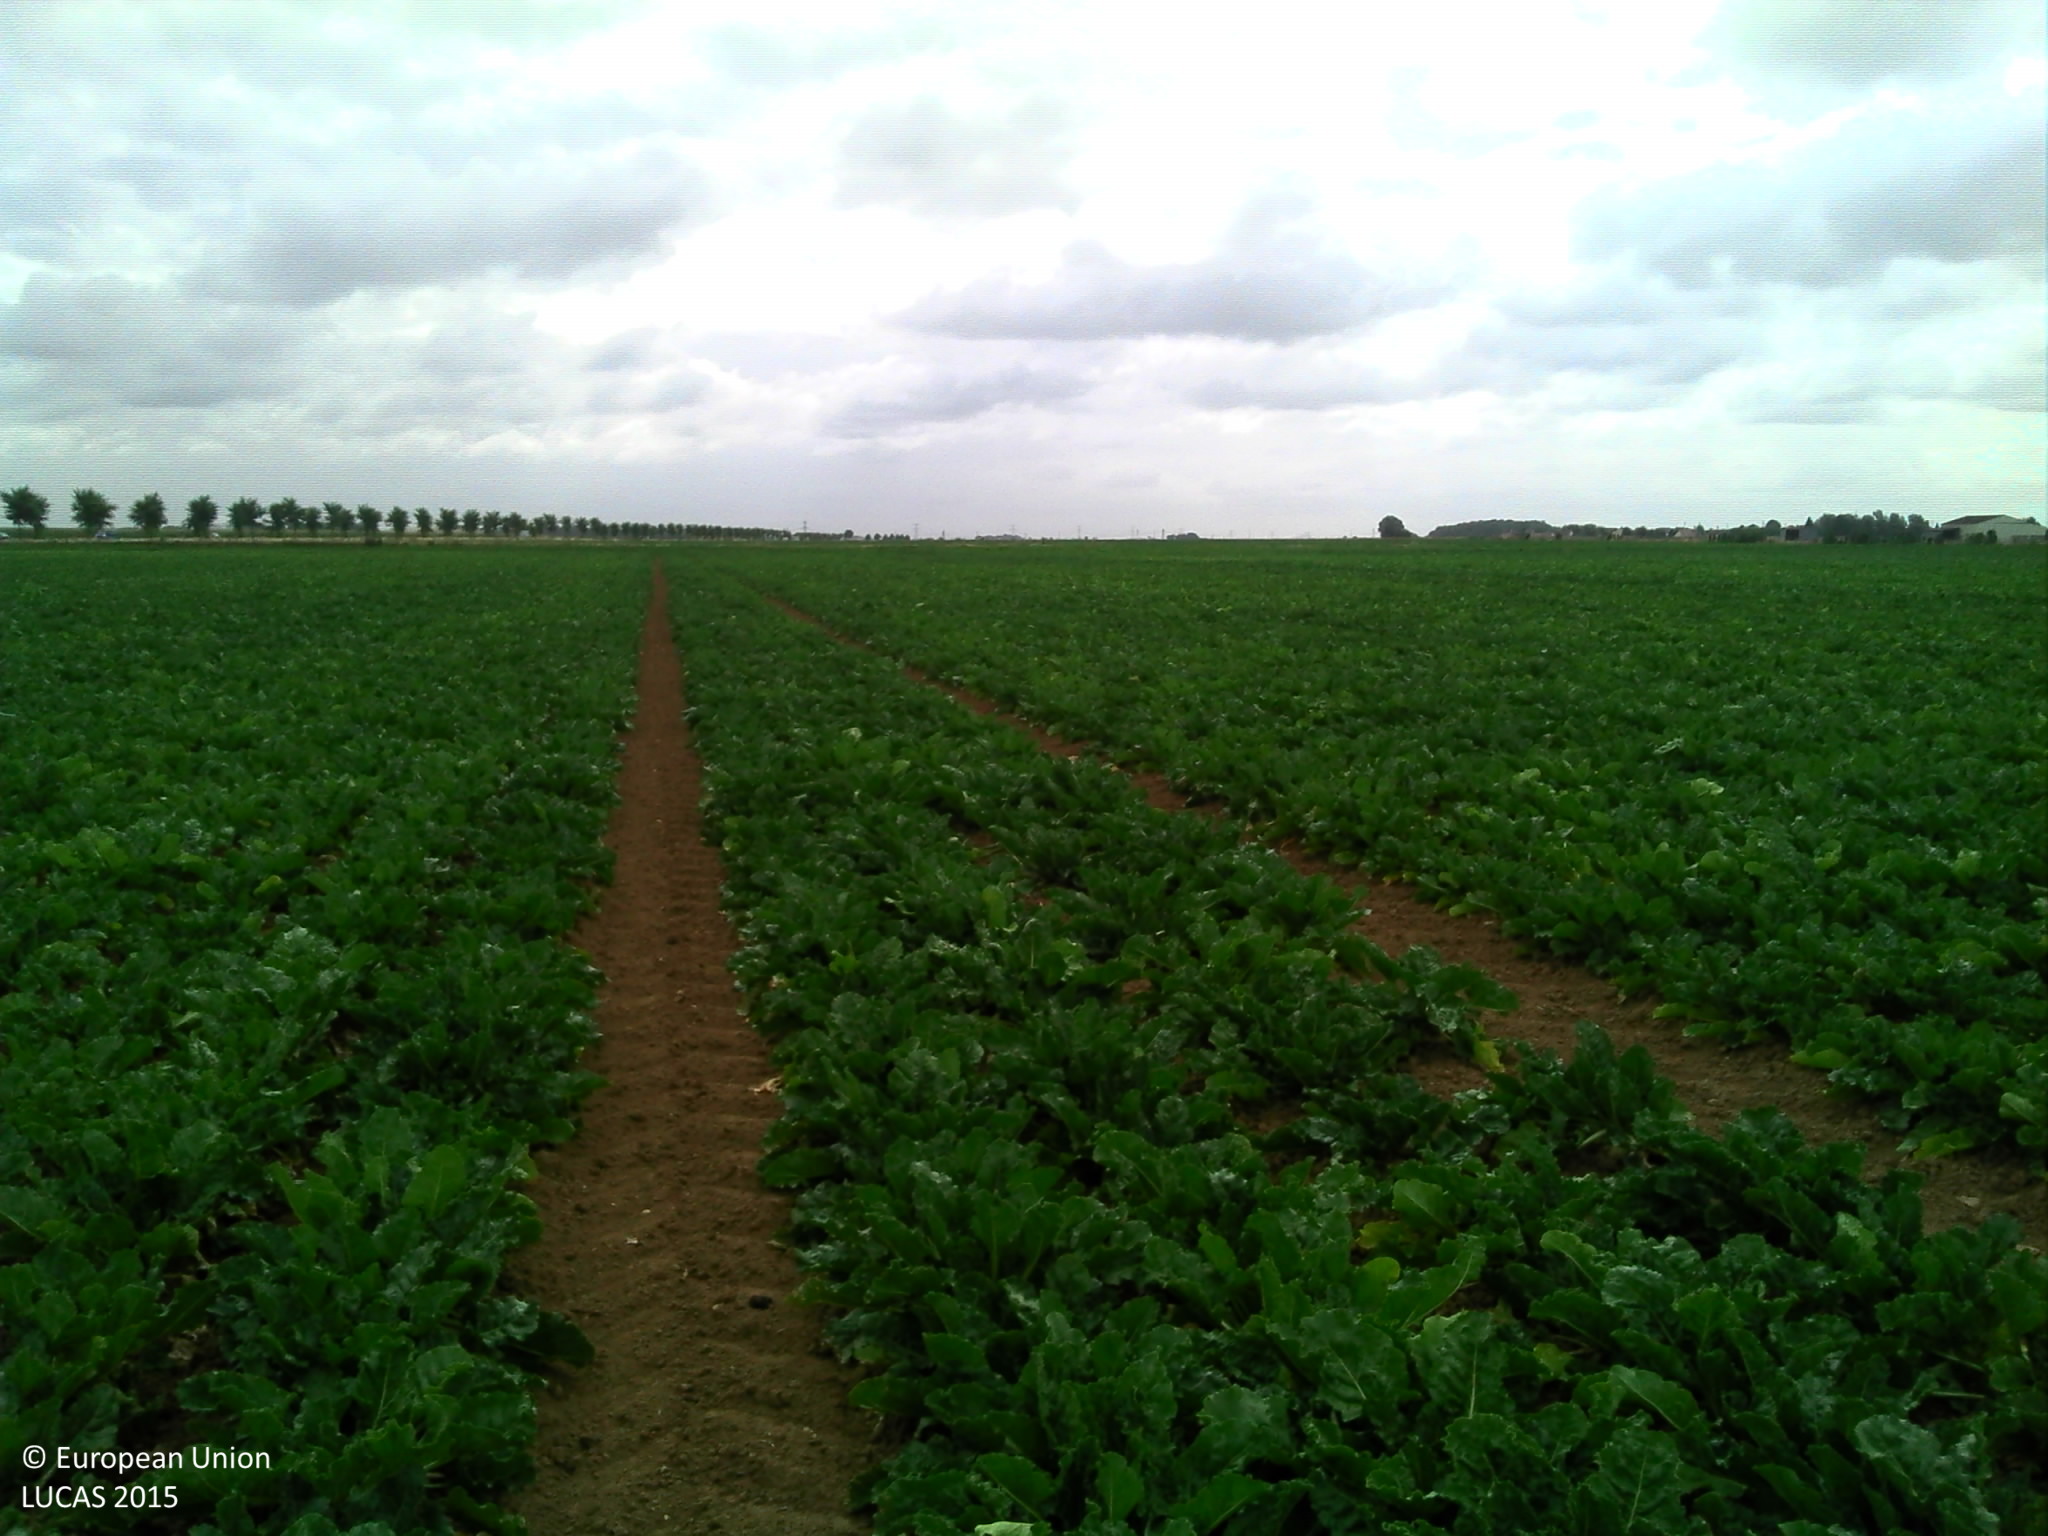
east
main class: Cropland
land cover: Sugar beet
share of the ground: > 75 %
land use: Agriculture (excluding fallow land and kitchen gardens)
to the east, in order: Sugar beet; Tracks; Sugar beet
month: July
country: FR
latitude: 48.6302
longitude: 2.6766
